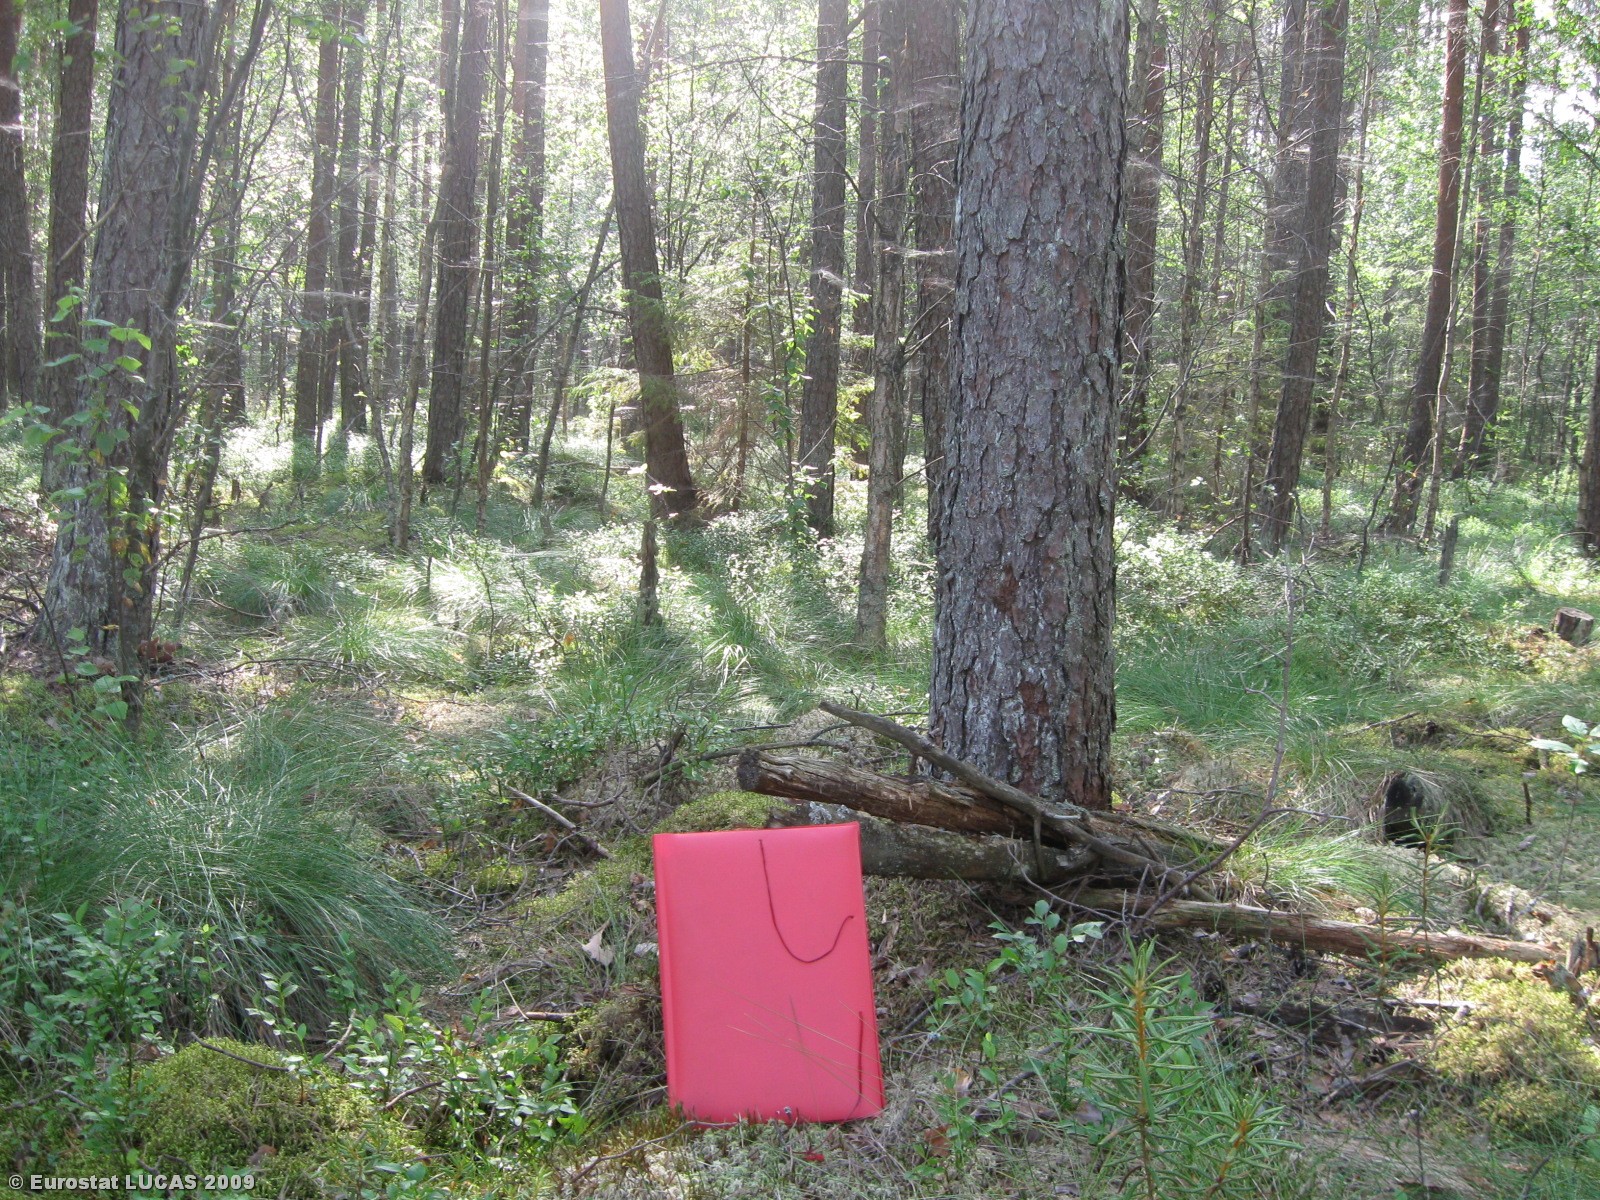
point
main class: Woodland
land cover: Mixed woodland
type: mire and swamp forests
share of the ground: > 75 %
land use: Forestry
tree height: > 5 m
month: July
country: LT
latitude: 54.3460
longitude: 25.1485
